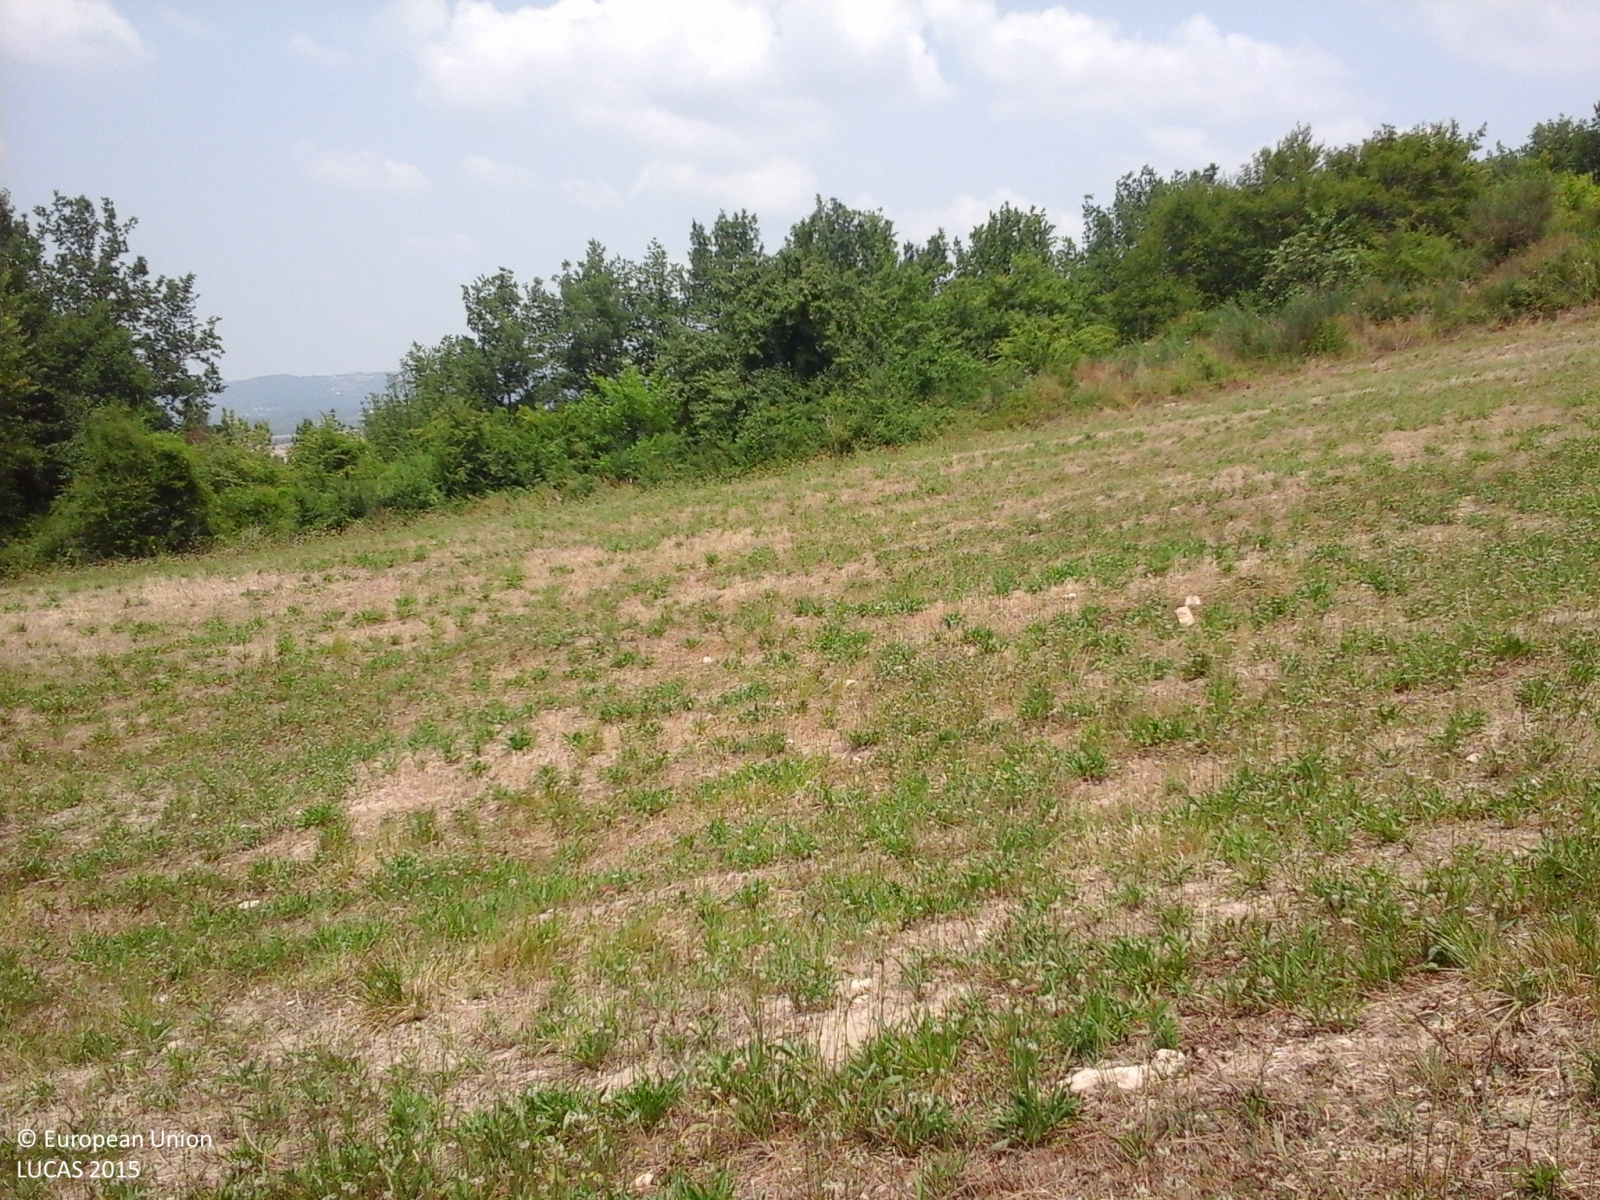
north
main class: Grassland
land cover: Spontaneously vegetated surfaces
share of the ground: > 75 %
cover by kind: herbaceous plants 90 %, consolidated bare surface 10 %
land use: Agriculture (excluding fallow land and kitchen gardens)
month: July
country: IT
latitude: 40.9515
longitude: 15.0769
